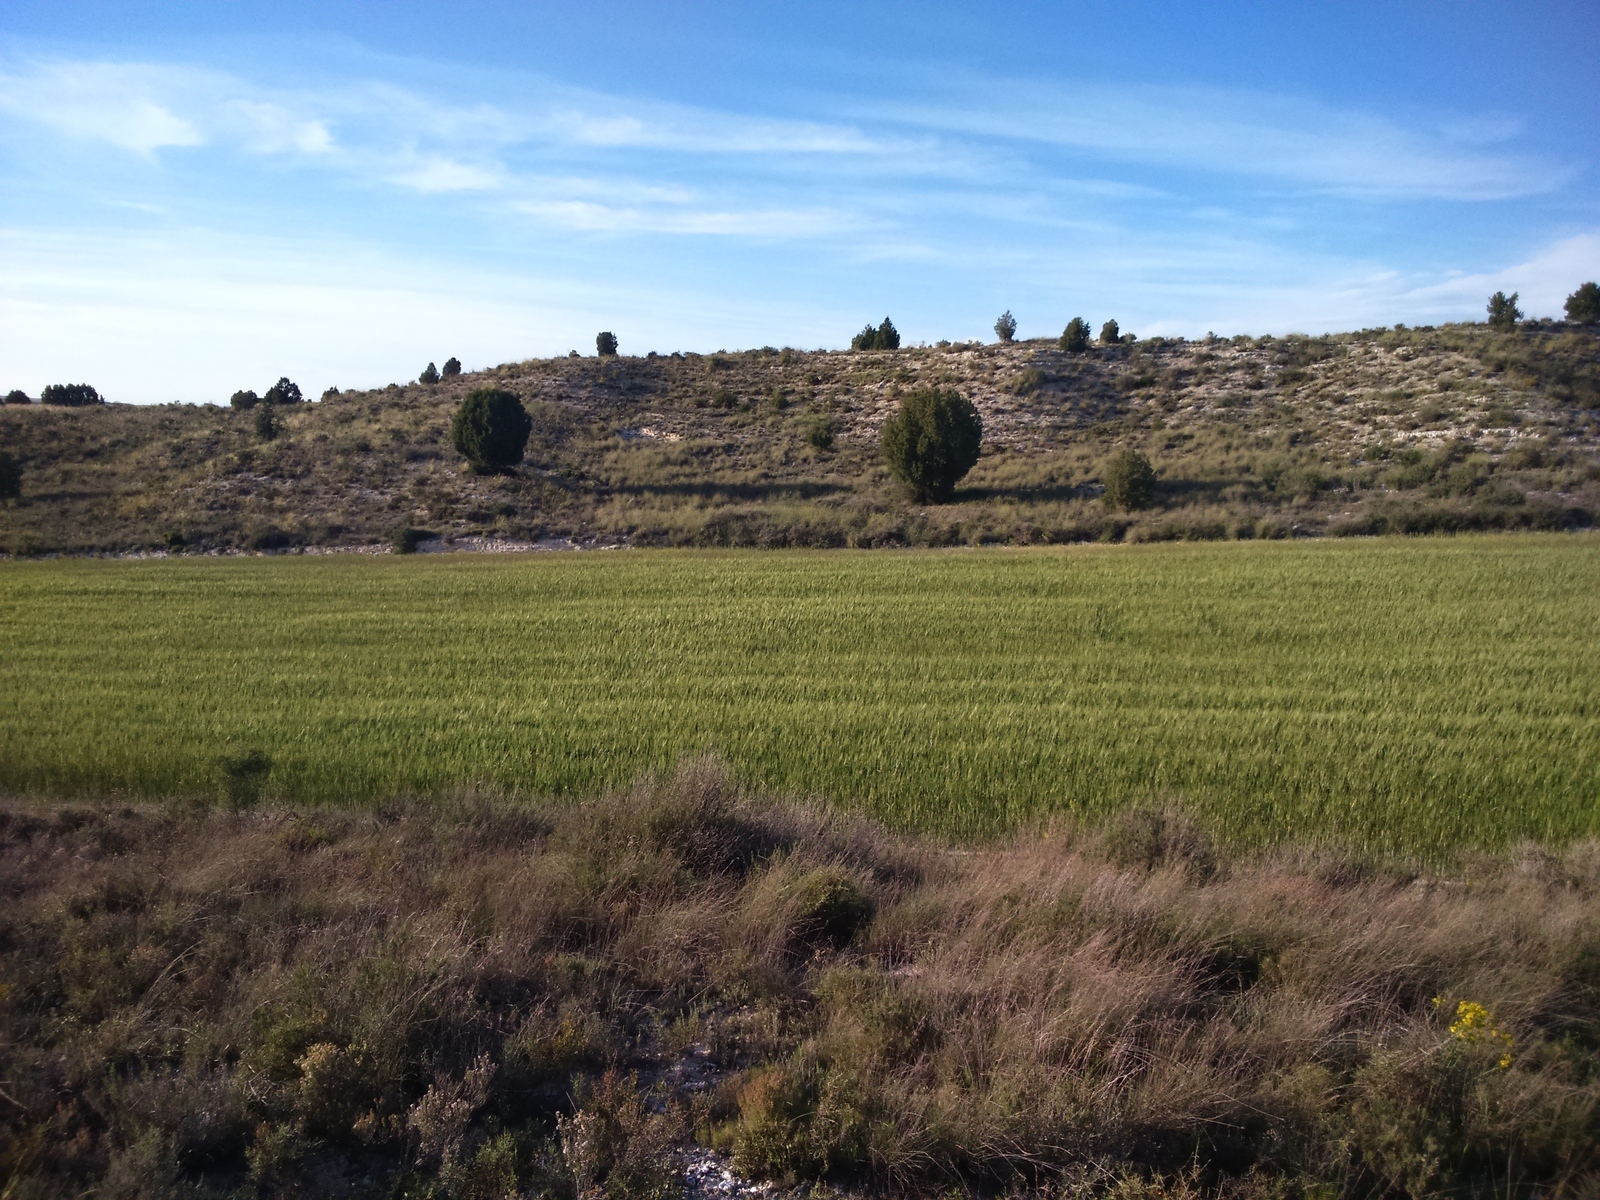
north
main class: Shrubland
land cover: Shrubland with sparse tree cover
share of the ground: > 75 %
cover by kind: shrubs 80 %, herbaceous plants 15 %, coniferous forest trees 5 %
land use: Semi-natural and natural areas not in use
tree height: < 5 m
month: April
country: ES
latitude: 41.4340
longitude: -0.3198
